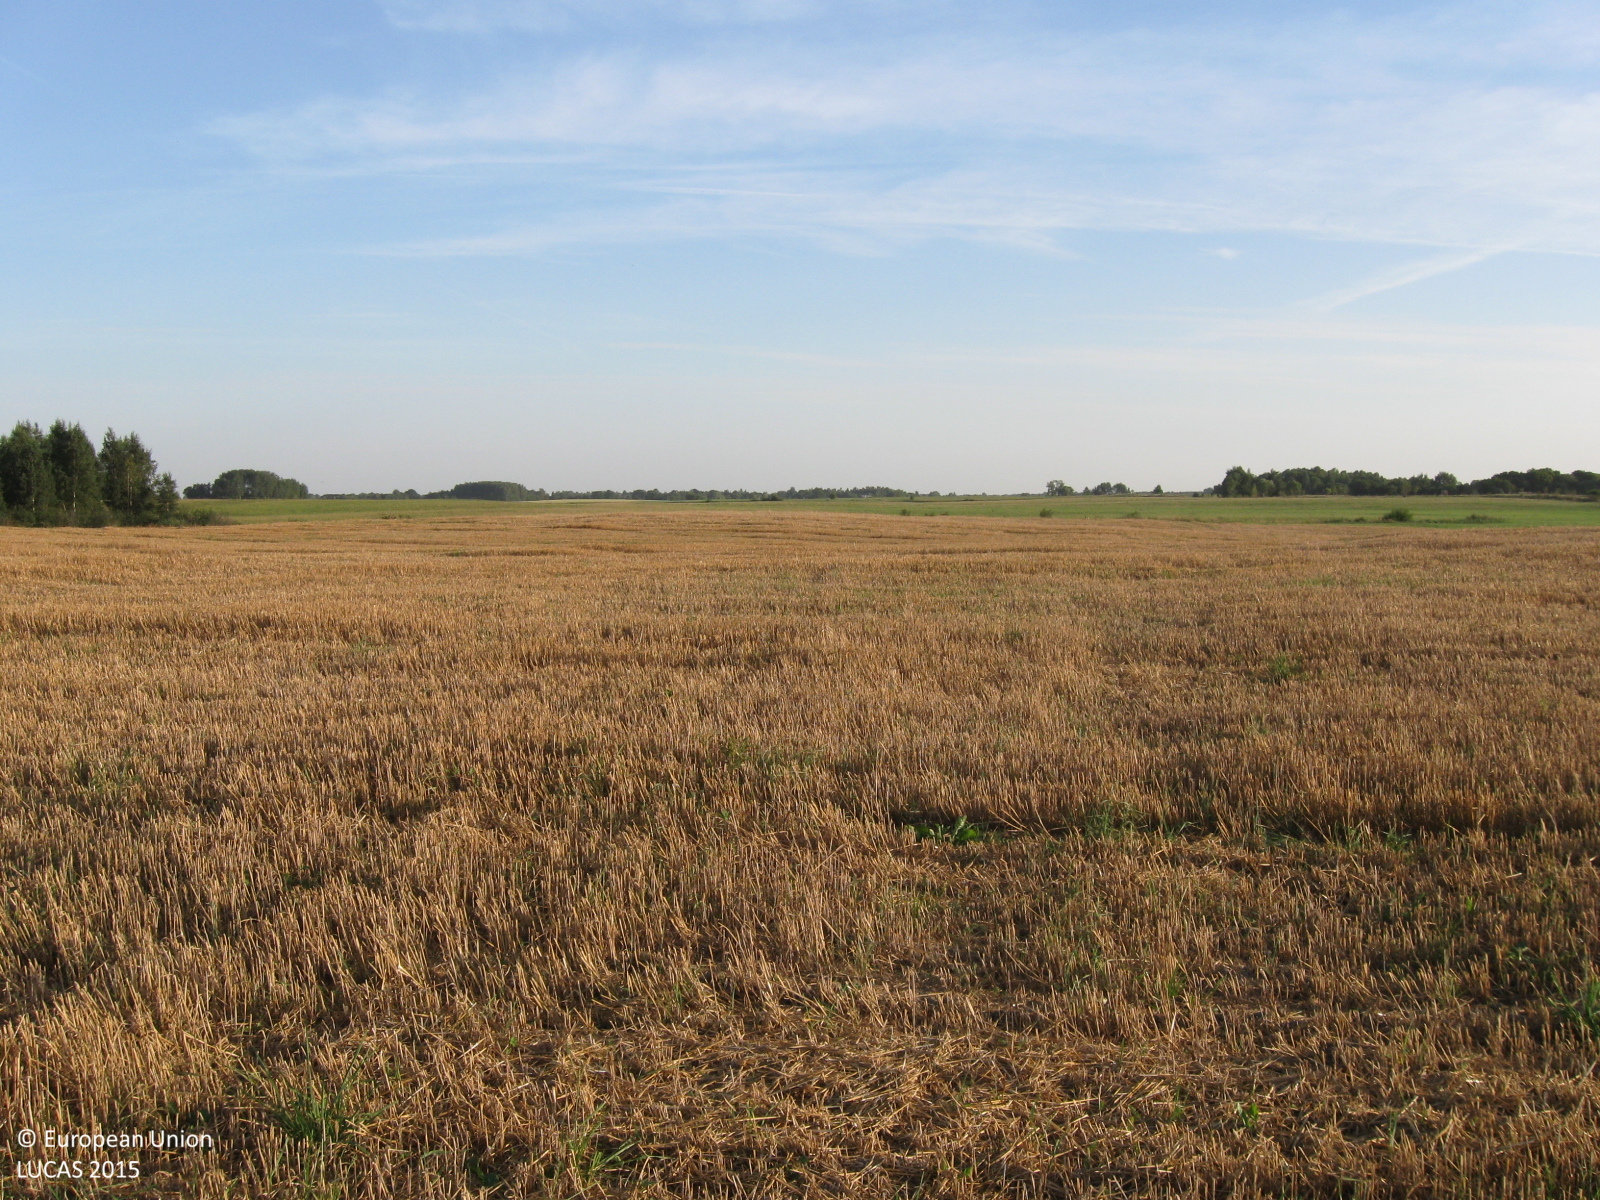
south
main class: Cropland
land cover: Barley
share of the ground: > 75 %
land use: Agriculture (excluding fallow land and kitchen gardens)
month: August
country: LT
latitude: 55.4685
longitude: 22.6388
